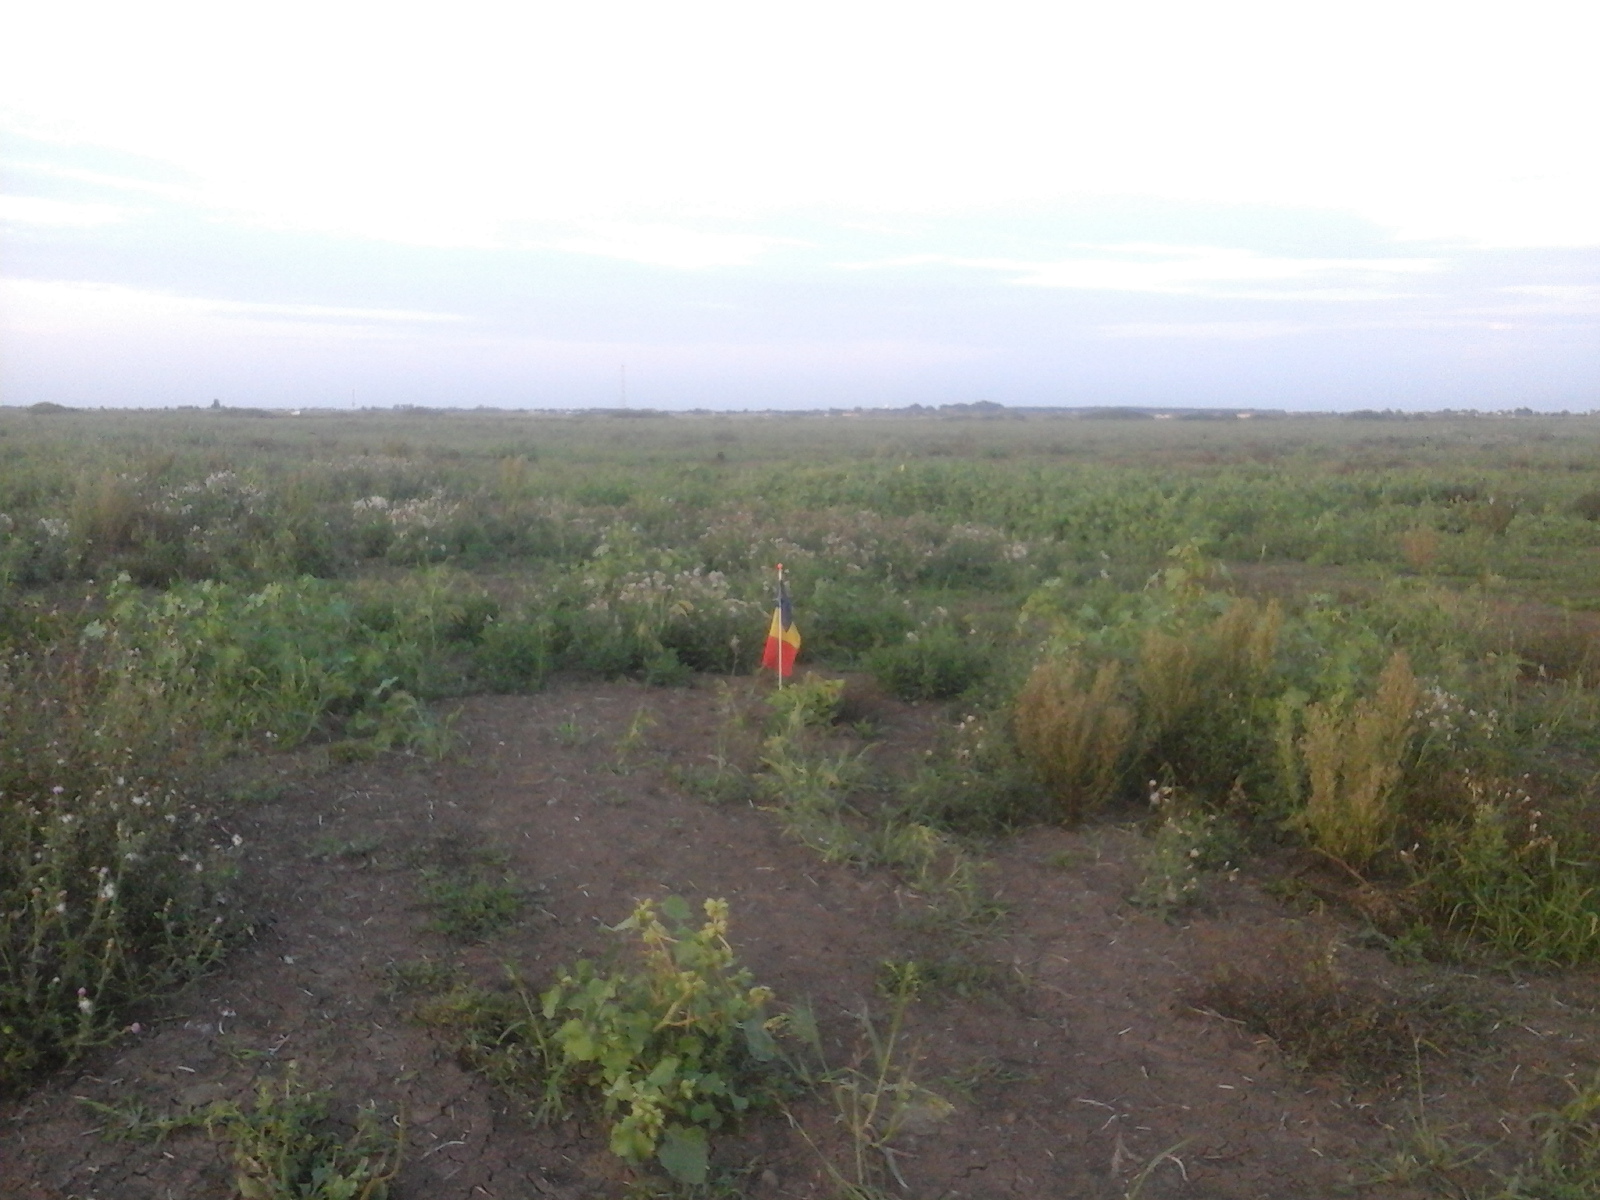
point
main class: Grassland
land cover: Spontaneously vegetated surfaces
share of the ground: > 75 %
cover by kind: herbaceous plants 100 %
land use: Agriculture (excluding fallow land and kitchen gardens)
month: August
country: RO
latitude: 46.6562
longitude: 21.4990
